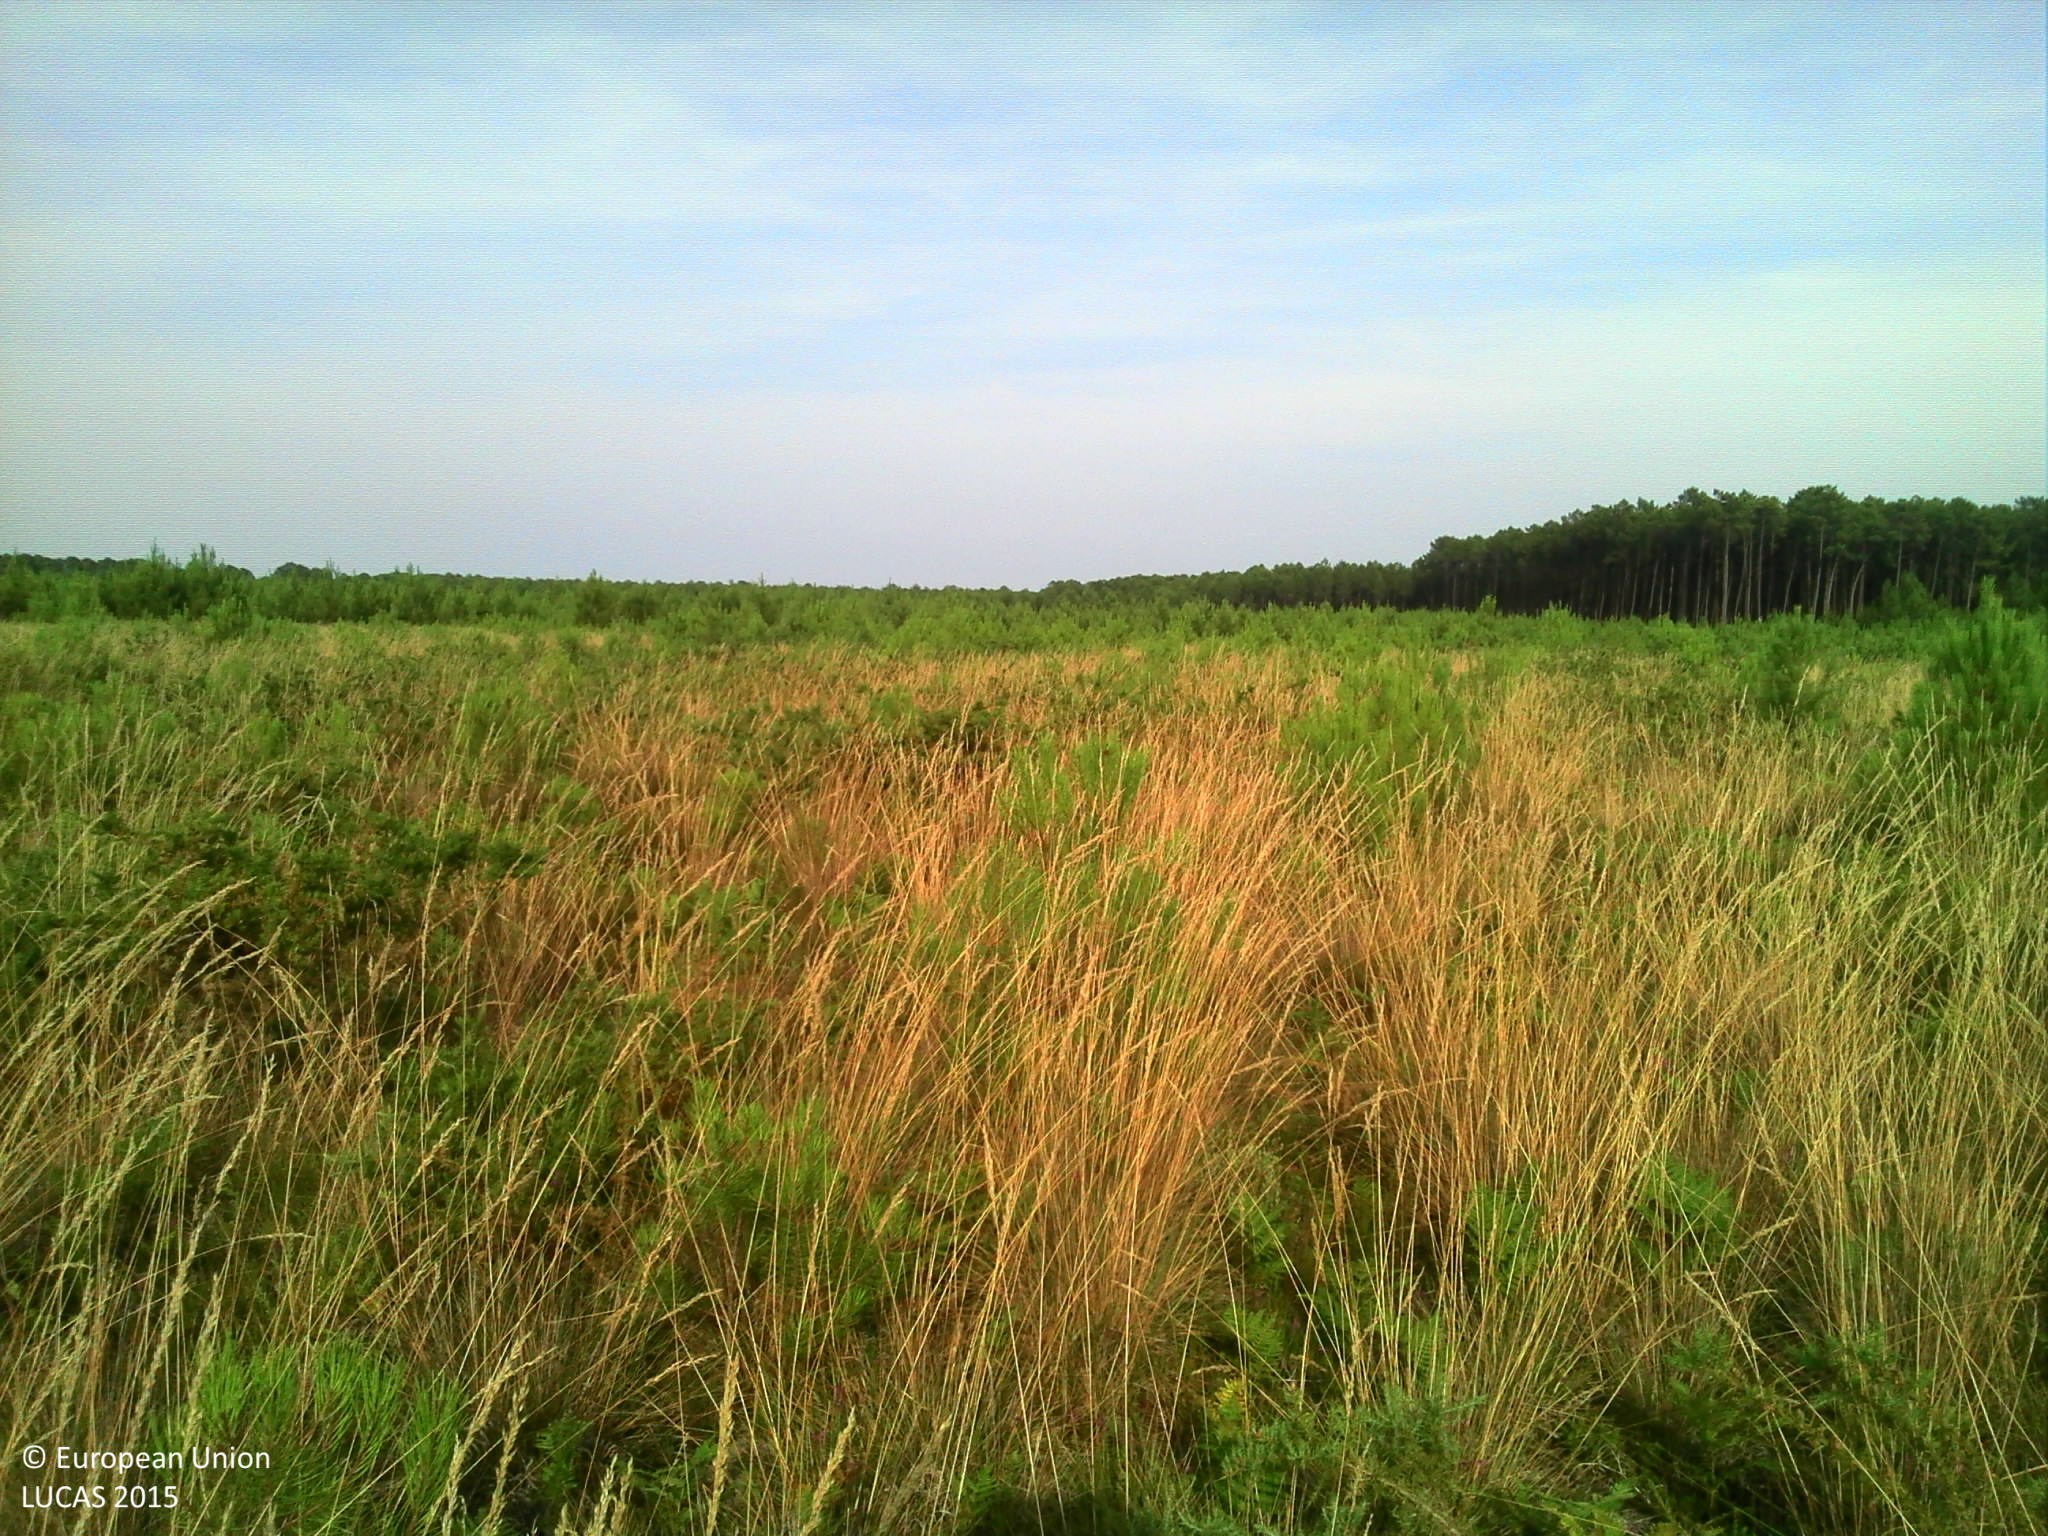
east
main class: Shrubland
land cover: Shrubland with sparse tree cover
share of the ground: > 75 %
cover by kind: shrubs 50 %, herbaceous plants 40 %, coniferous forest trees 5 %, lichens and mosses 5 %
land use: Forestry
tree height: < 5 m
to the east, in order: Shrubland with sparse tree cover; Pine dominated coniferous woodland
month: July
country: FR
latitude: 43.7309
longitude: -1.3035
